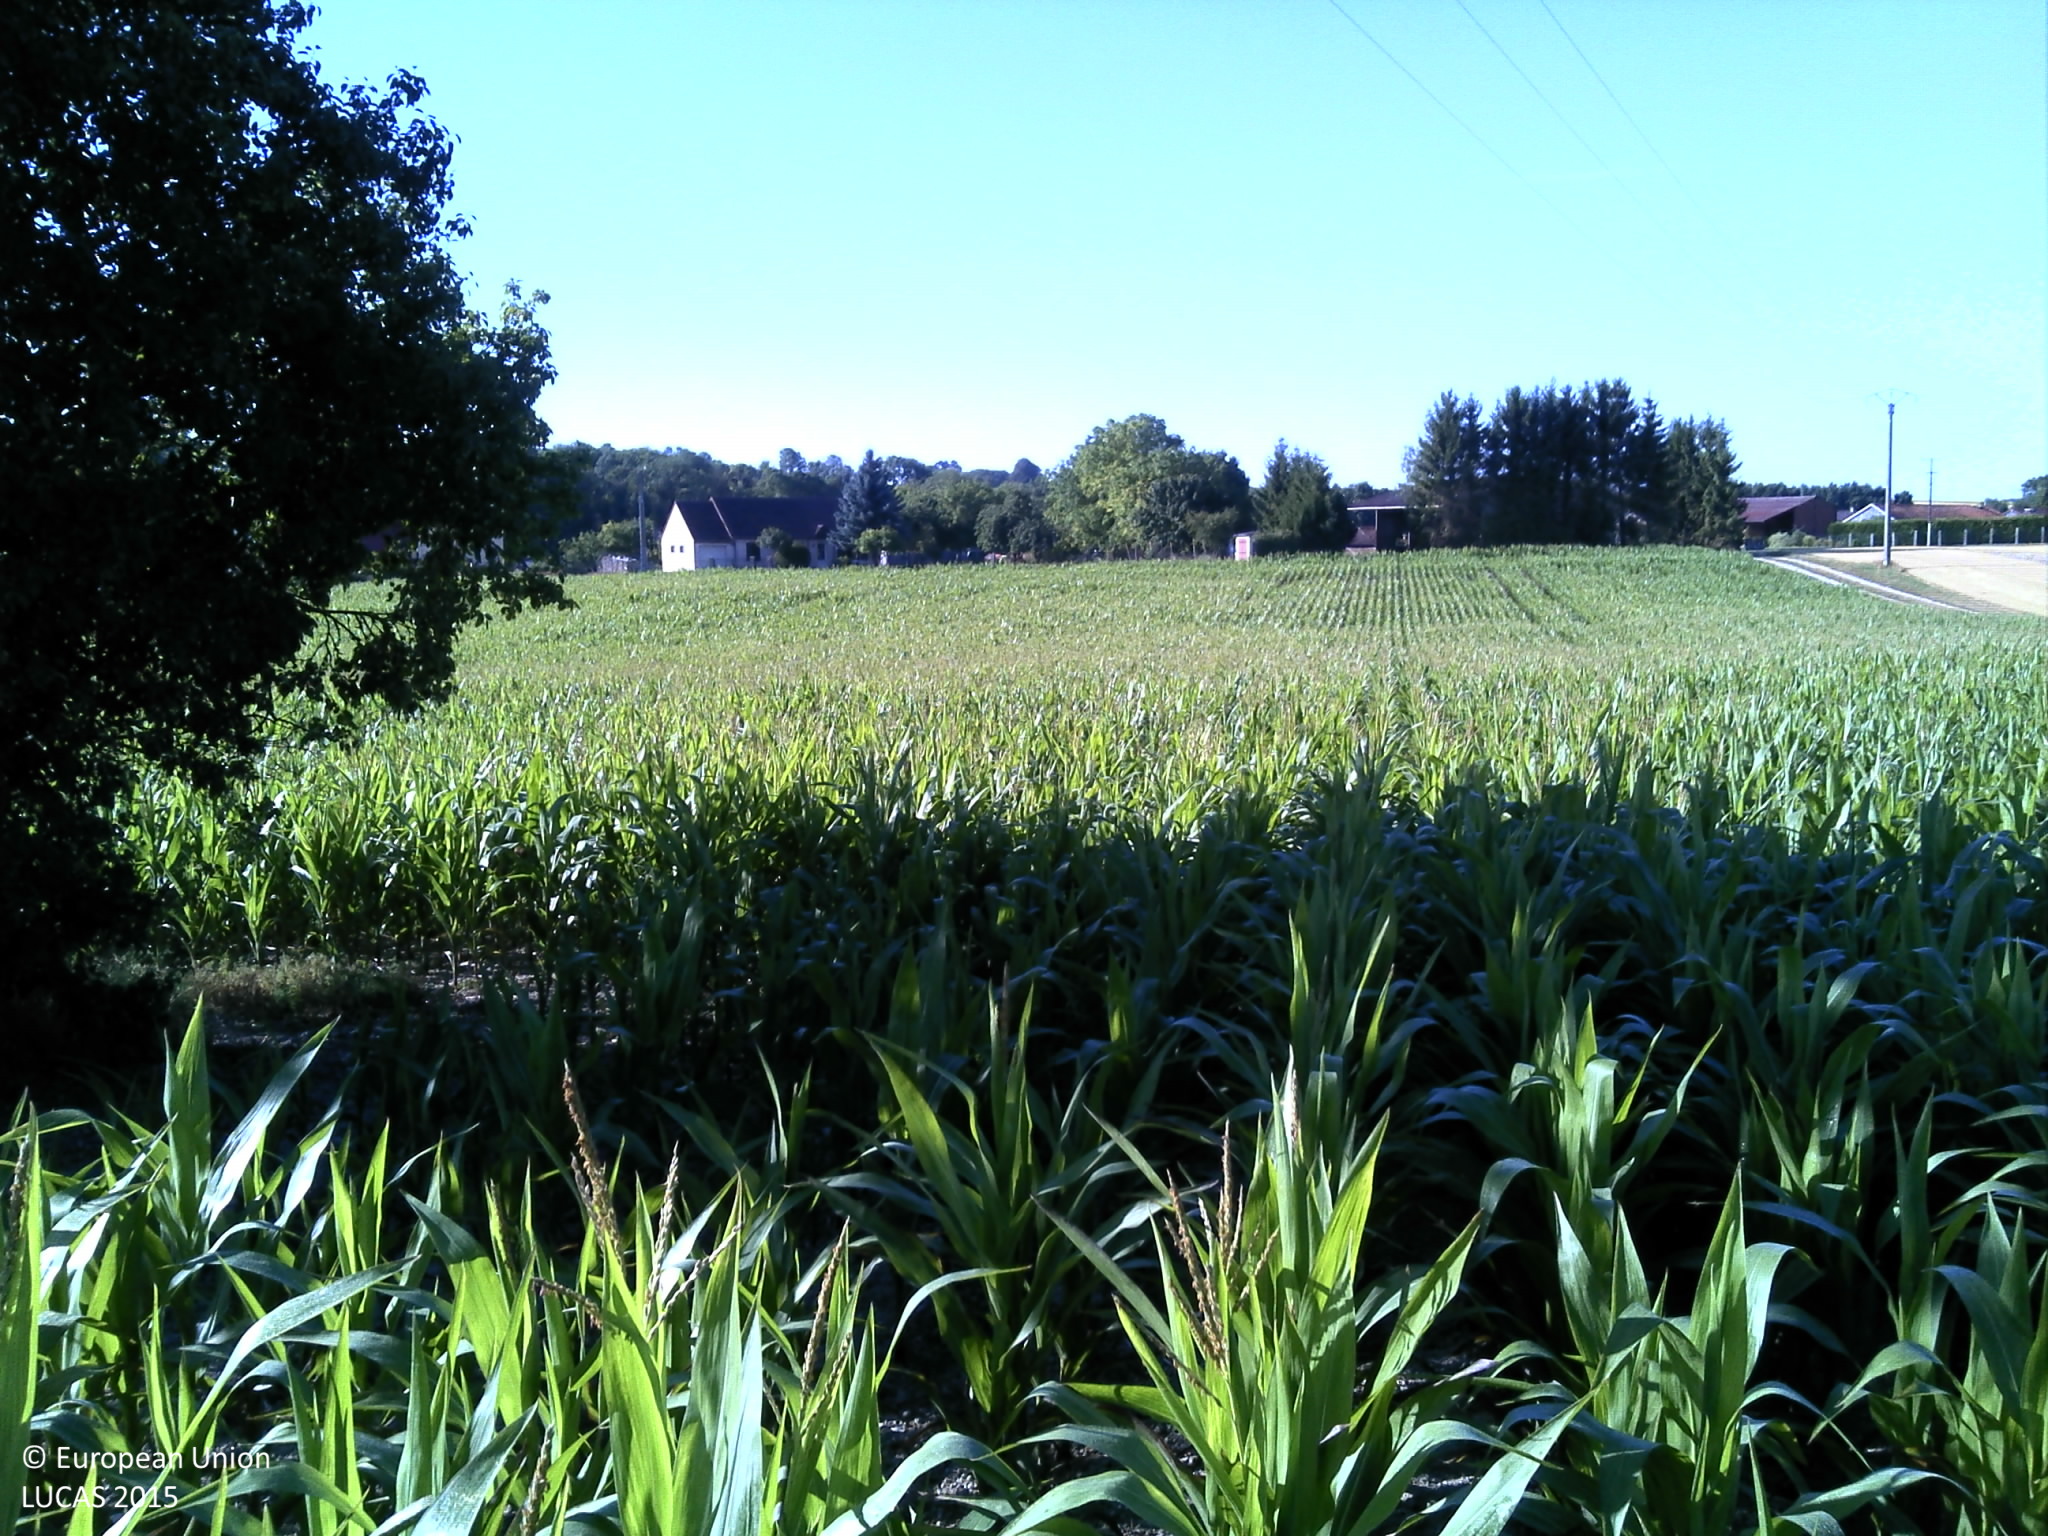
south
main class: Cropland
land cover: Maize
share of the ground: 50 - 75 %
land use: Agriculture (excluding fallow land and kitchen gardens)
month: August
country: FR
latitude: 49.1043
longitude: 4.6687
